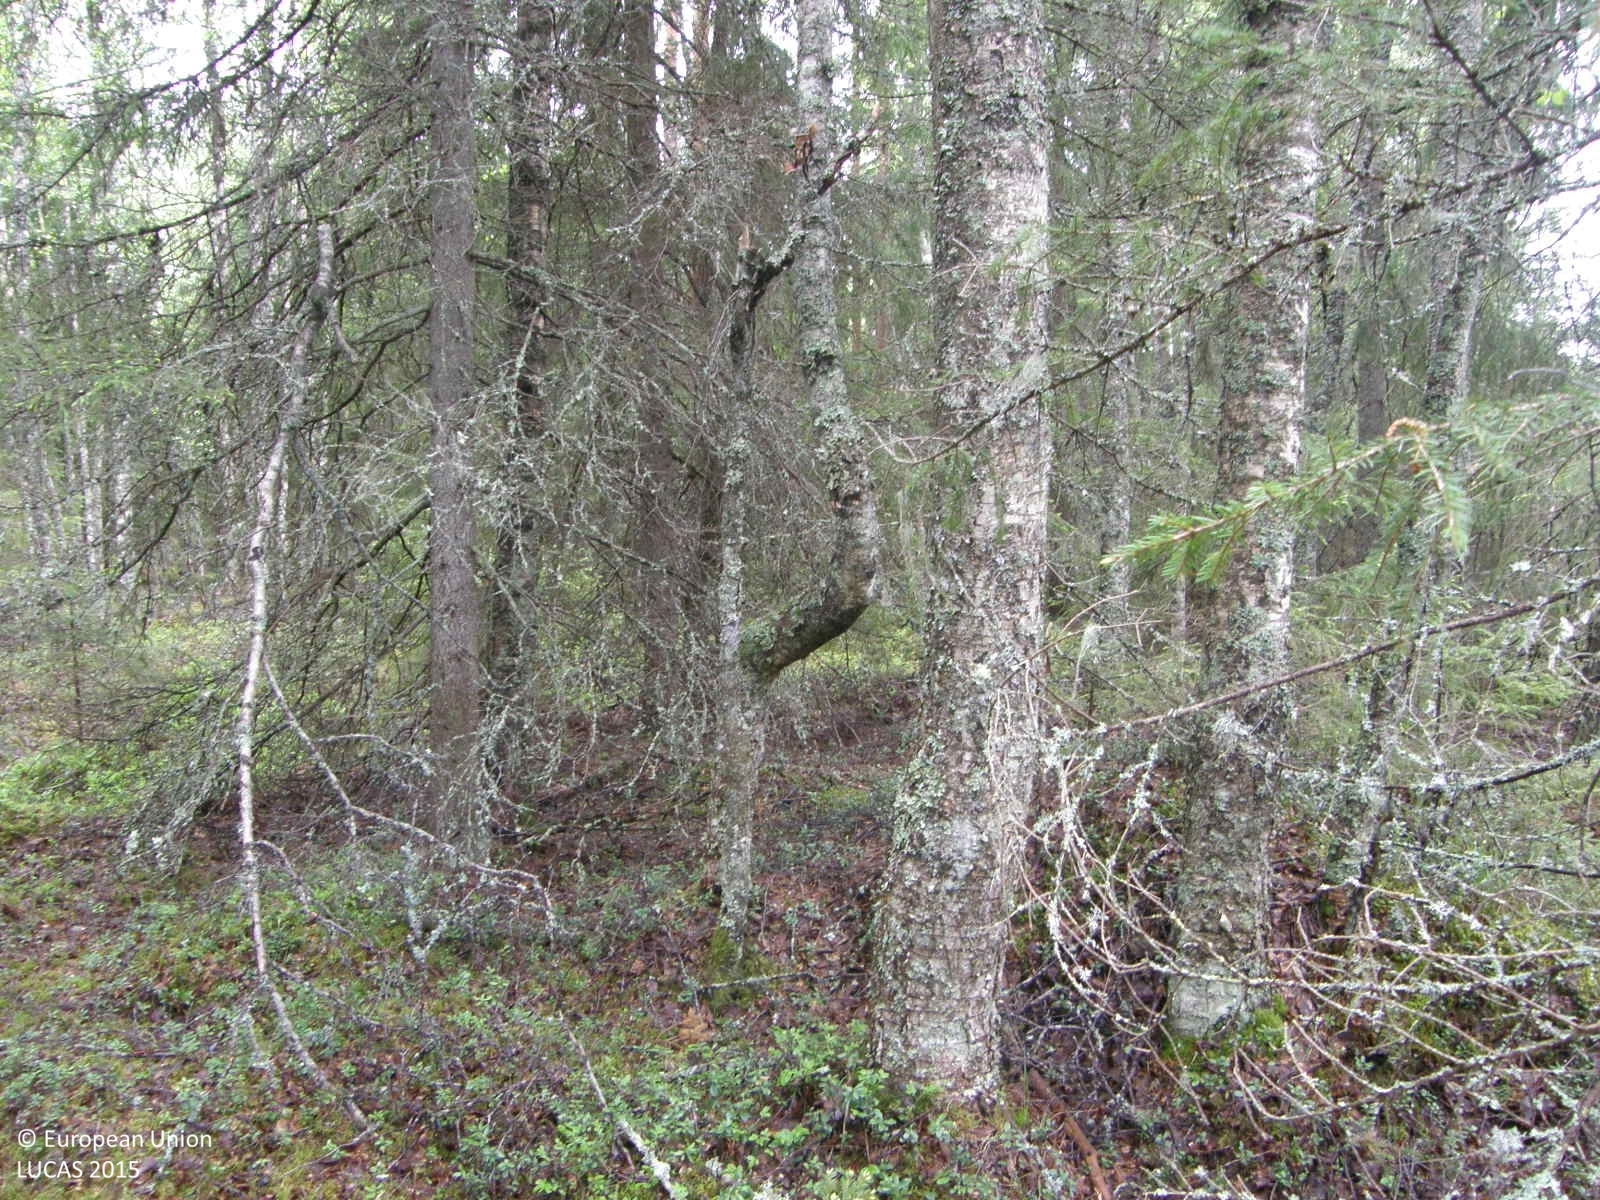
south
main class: Woodland
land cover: Other mixed woodland
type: boreal forest
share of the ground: > 75 %
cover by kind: coniferous forest trees 60 %, broadleaved forest trees 25 %, shrubs 15 %
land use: Forestry
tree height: > 5 m
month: June
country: FI
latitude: 62.0395
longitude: 21.7695
